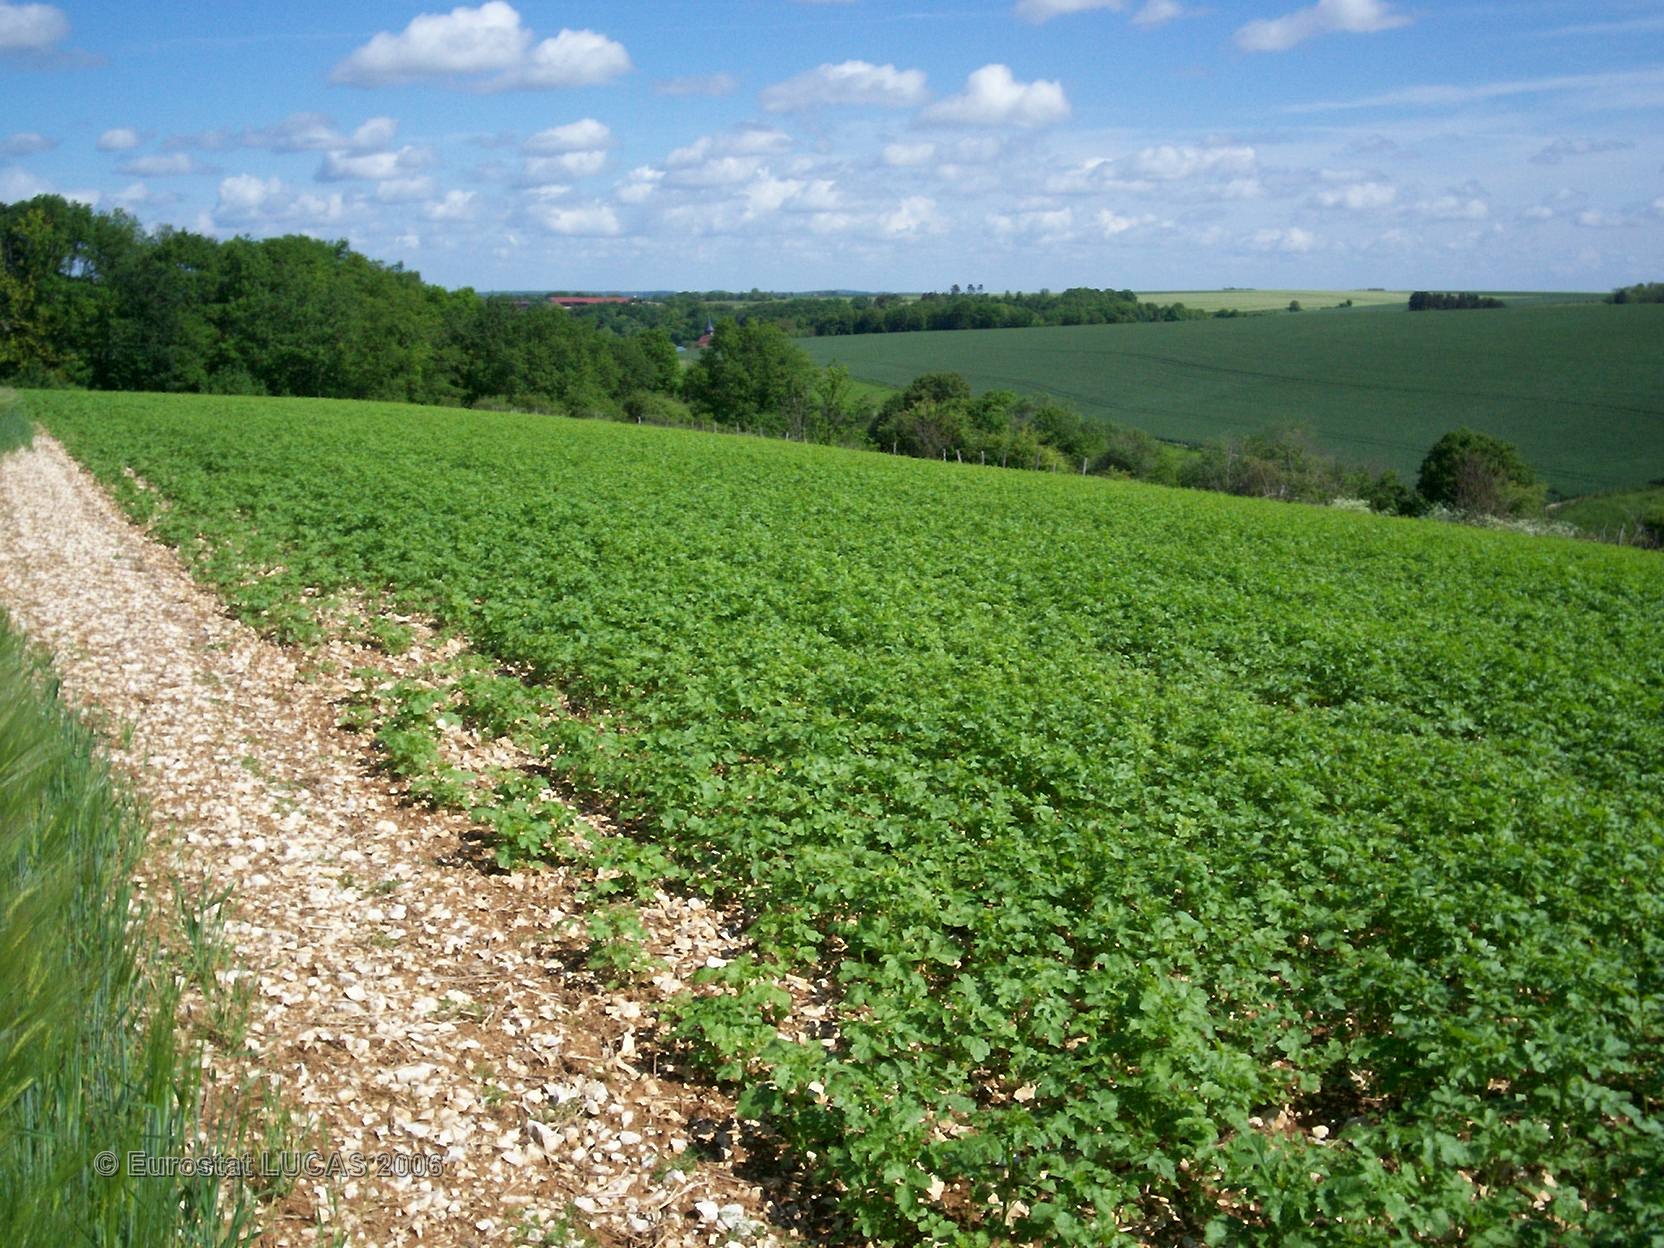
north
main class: Cropland
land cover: Barley
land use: Agriculture (excluding fallow land and kitchen gardens)
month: May
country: FR
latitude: 48.1777
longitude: 4.5242
